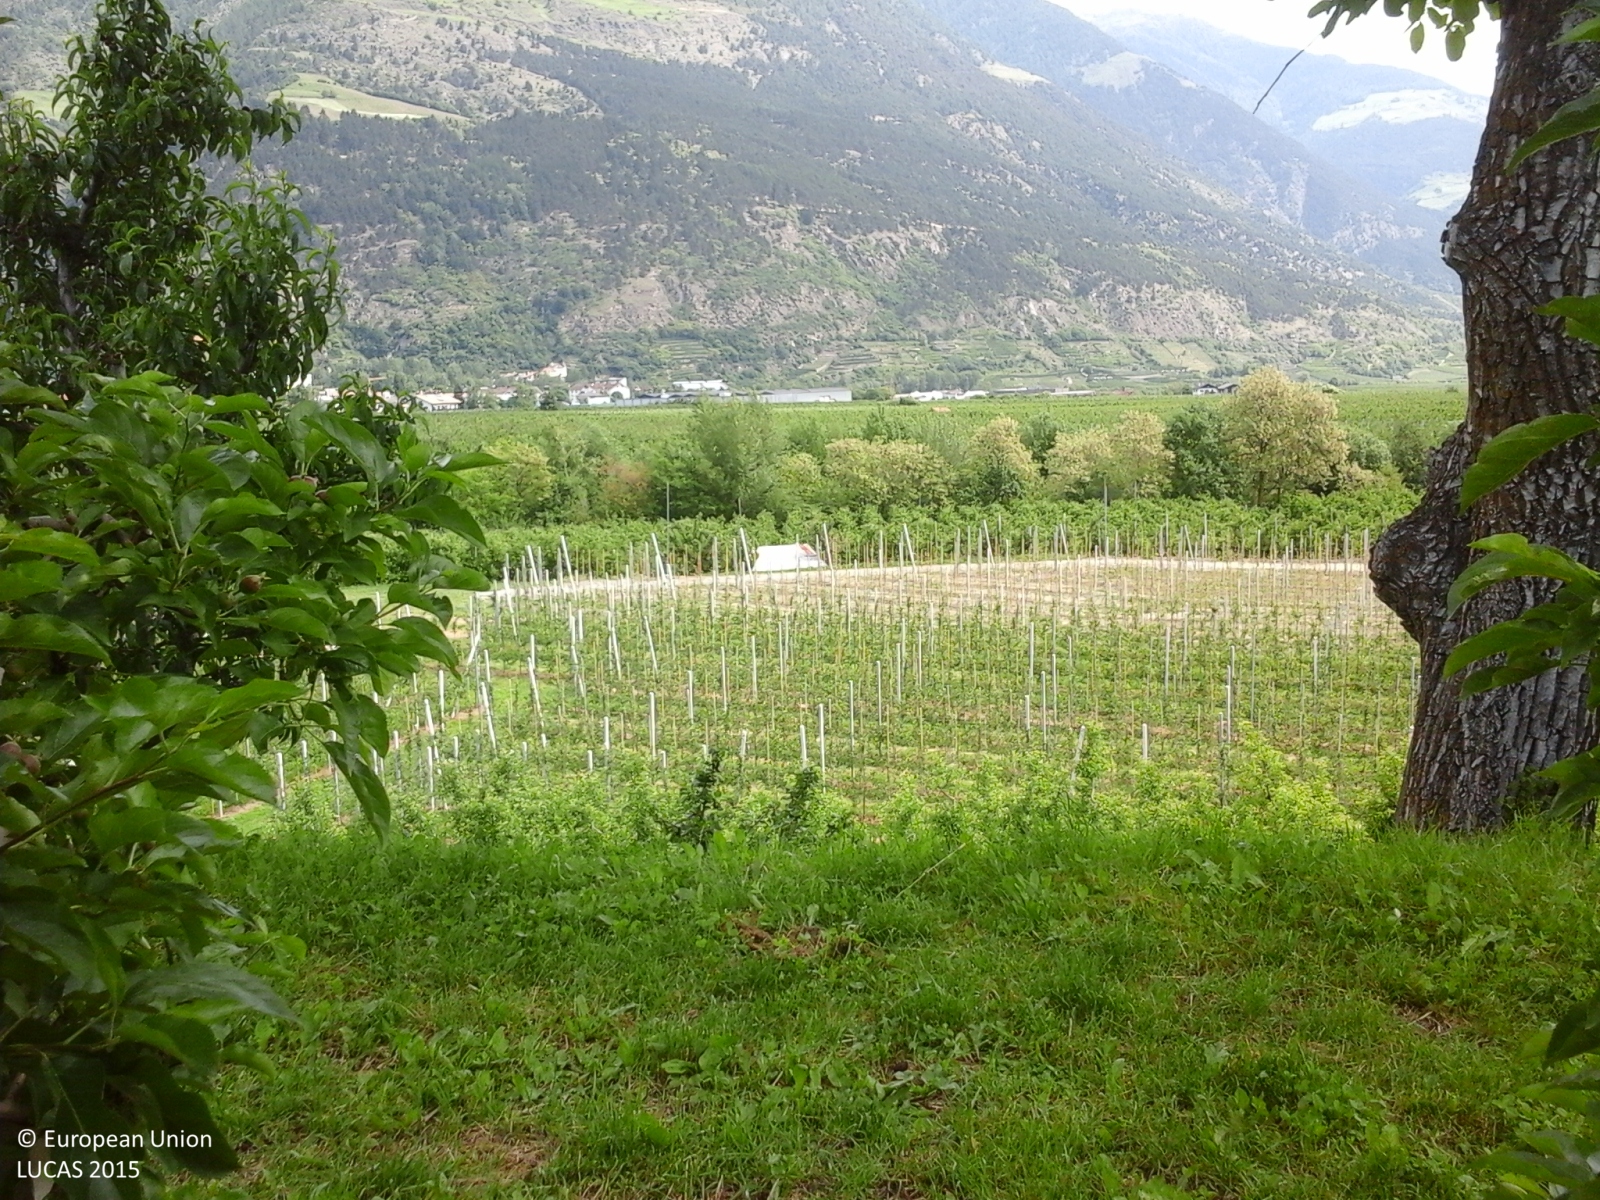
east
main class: Cropland
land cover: Apple fruit
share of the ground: > 75 %
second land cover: Grassland without tree/shrub cover
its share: > 75 %
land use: Agriculture (excluding fallow land and kitchen gardens)
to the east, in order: Apple fruit; Grassland without tree/shrub cover; Grassland with sparse tree/shrub cover; Apple fruit; Tracks; Apple fruit; Grassland without tree/shrub cover; Apple fruit; Abandoned hedges; Inland fresh running water; Broadleaved woodland; Tracks; Grassland without tree/shrub cover; Apple fruit
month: May
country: IT
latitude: 46.6186
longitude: 10.7695
